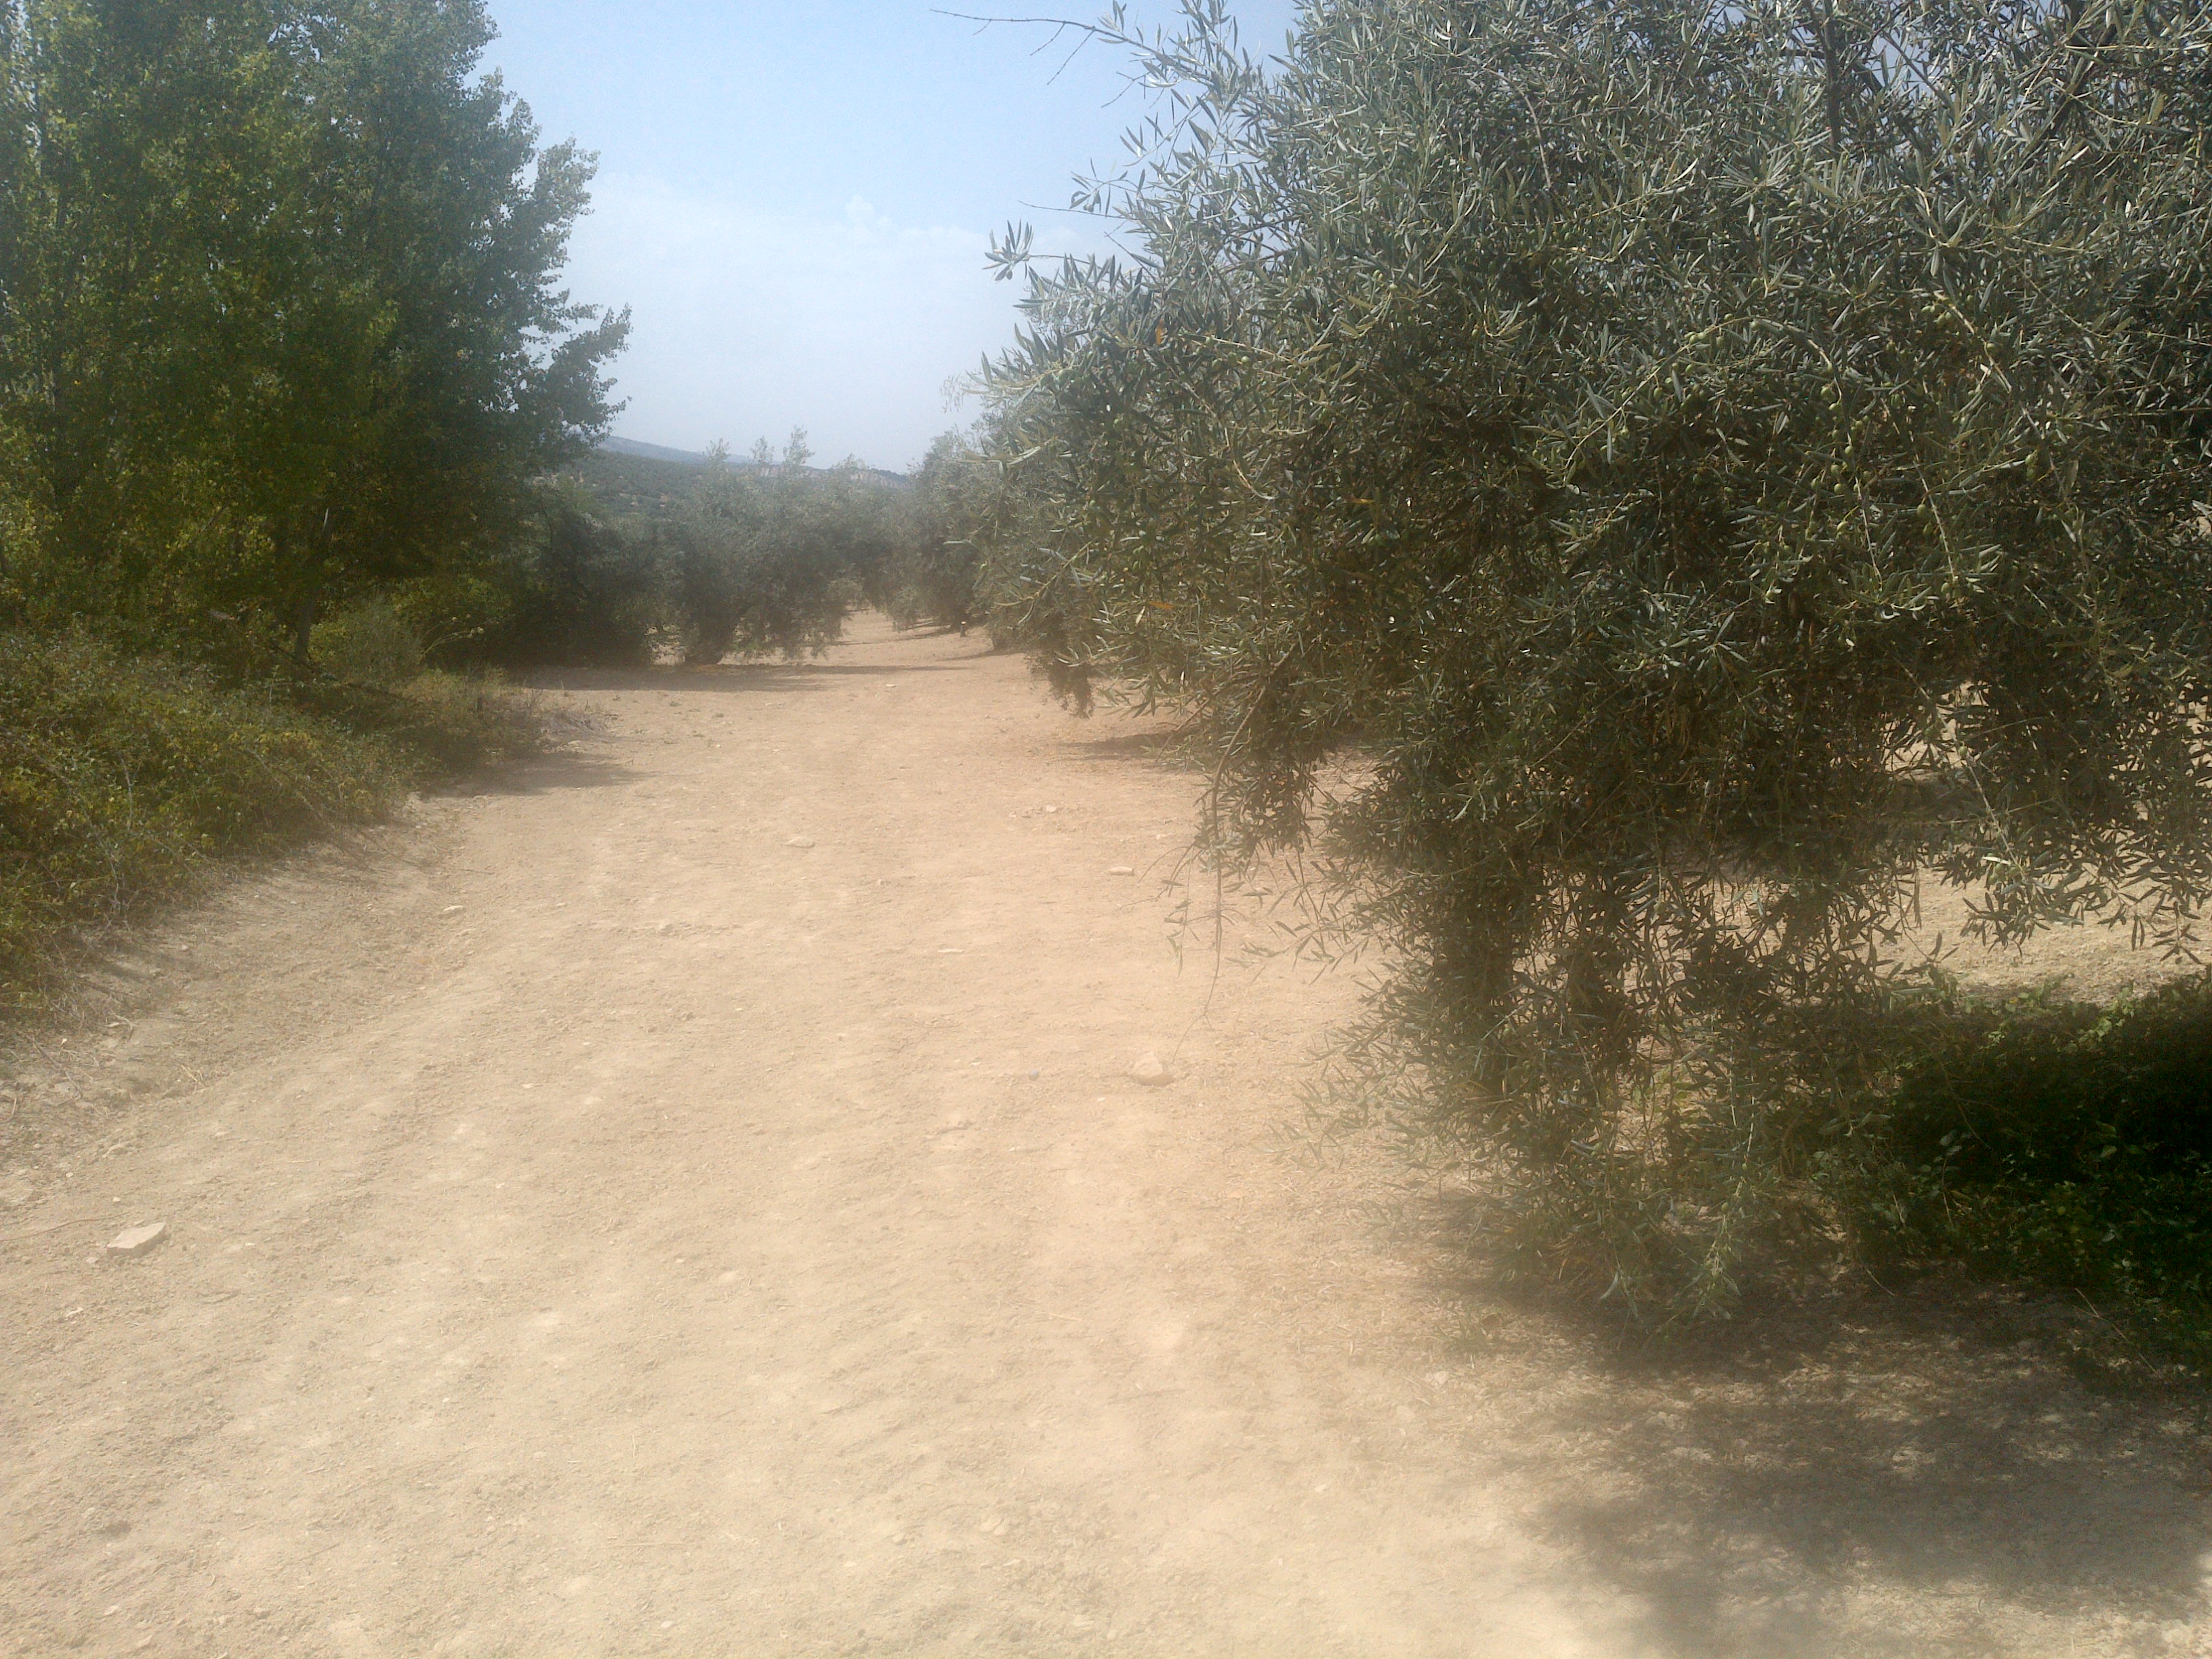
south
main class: Cropland
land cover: Olive groves
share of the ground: 50 - 75 %
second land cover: Other bare soil
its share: > 75 %
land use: Agriculture (excluding fallow land and kitchen gardens)
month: July
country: ES
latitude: 37.5409
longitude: -4.4343
